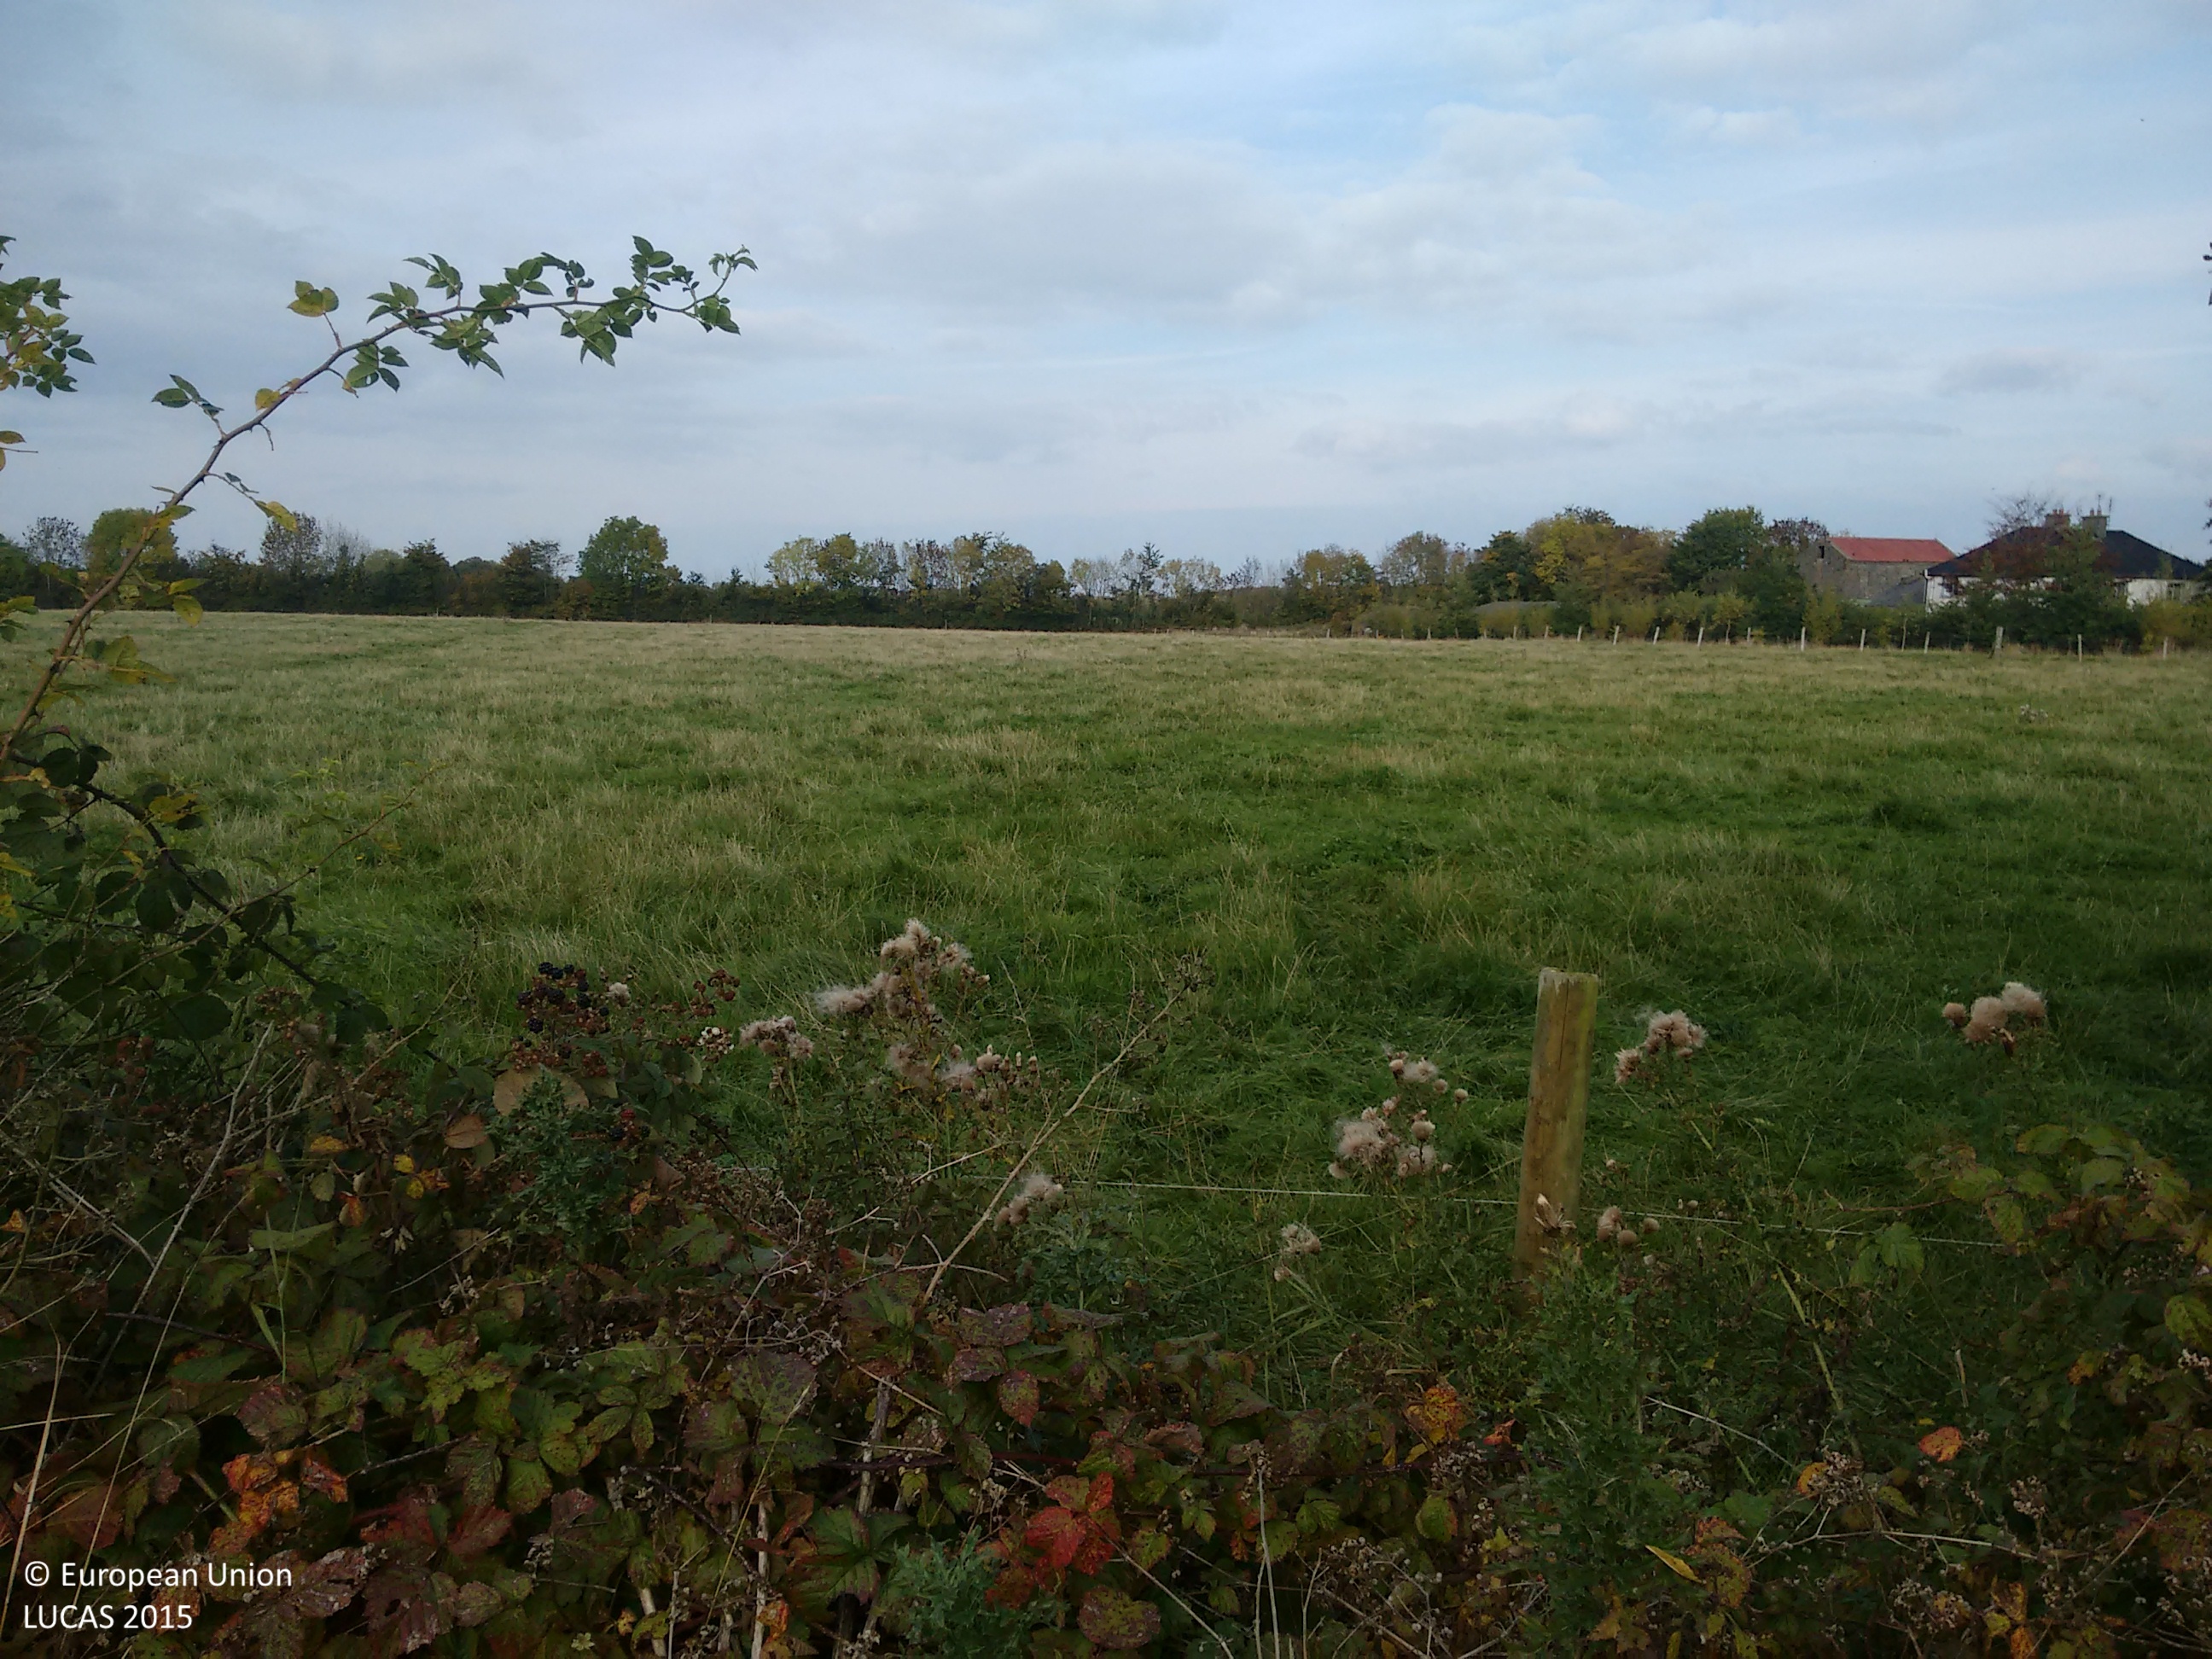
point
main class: Grassland
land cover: Grassland without tree/shrub cover
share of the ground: > 75 %
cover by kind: herbaceous plants 100 %
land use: Agriculture (excluding fallow land and kitchen gardens)
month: October
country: IE
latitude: 52.9511
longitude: -7.9296
